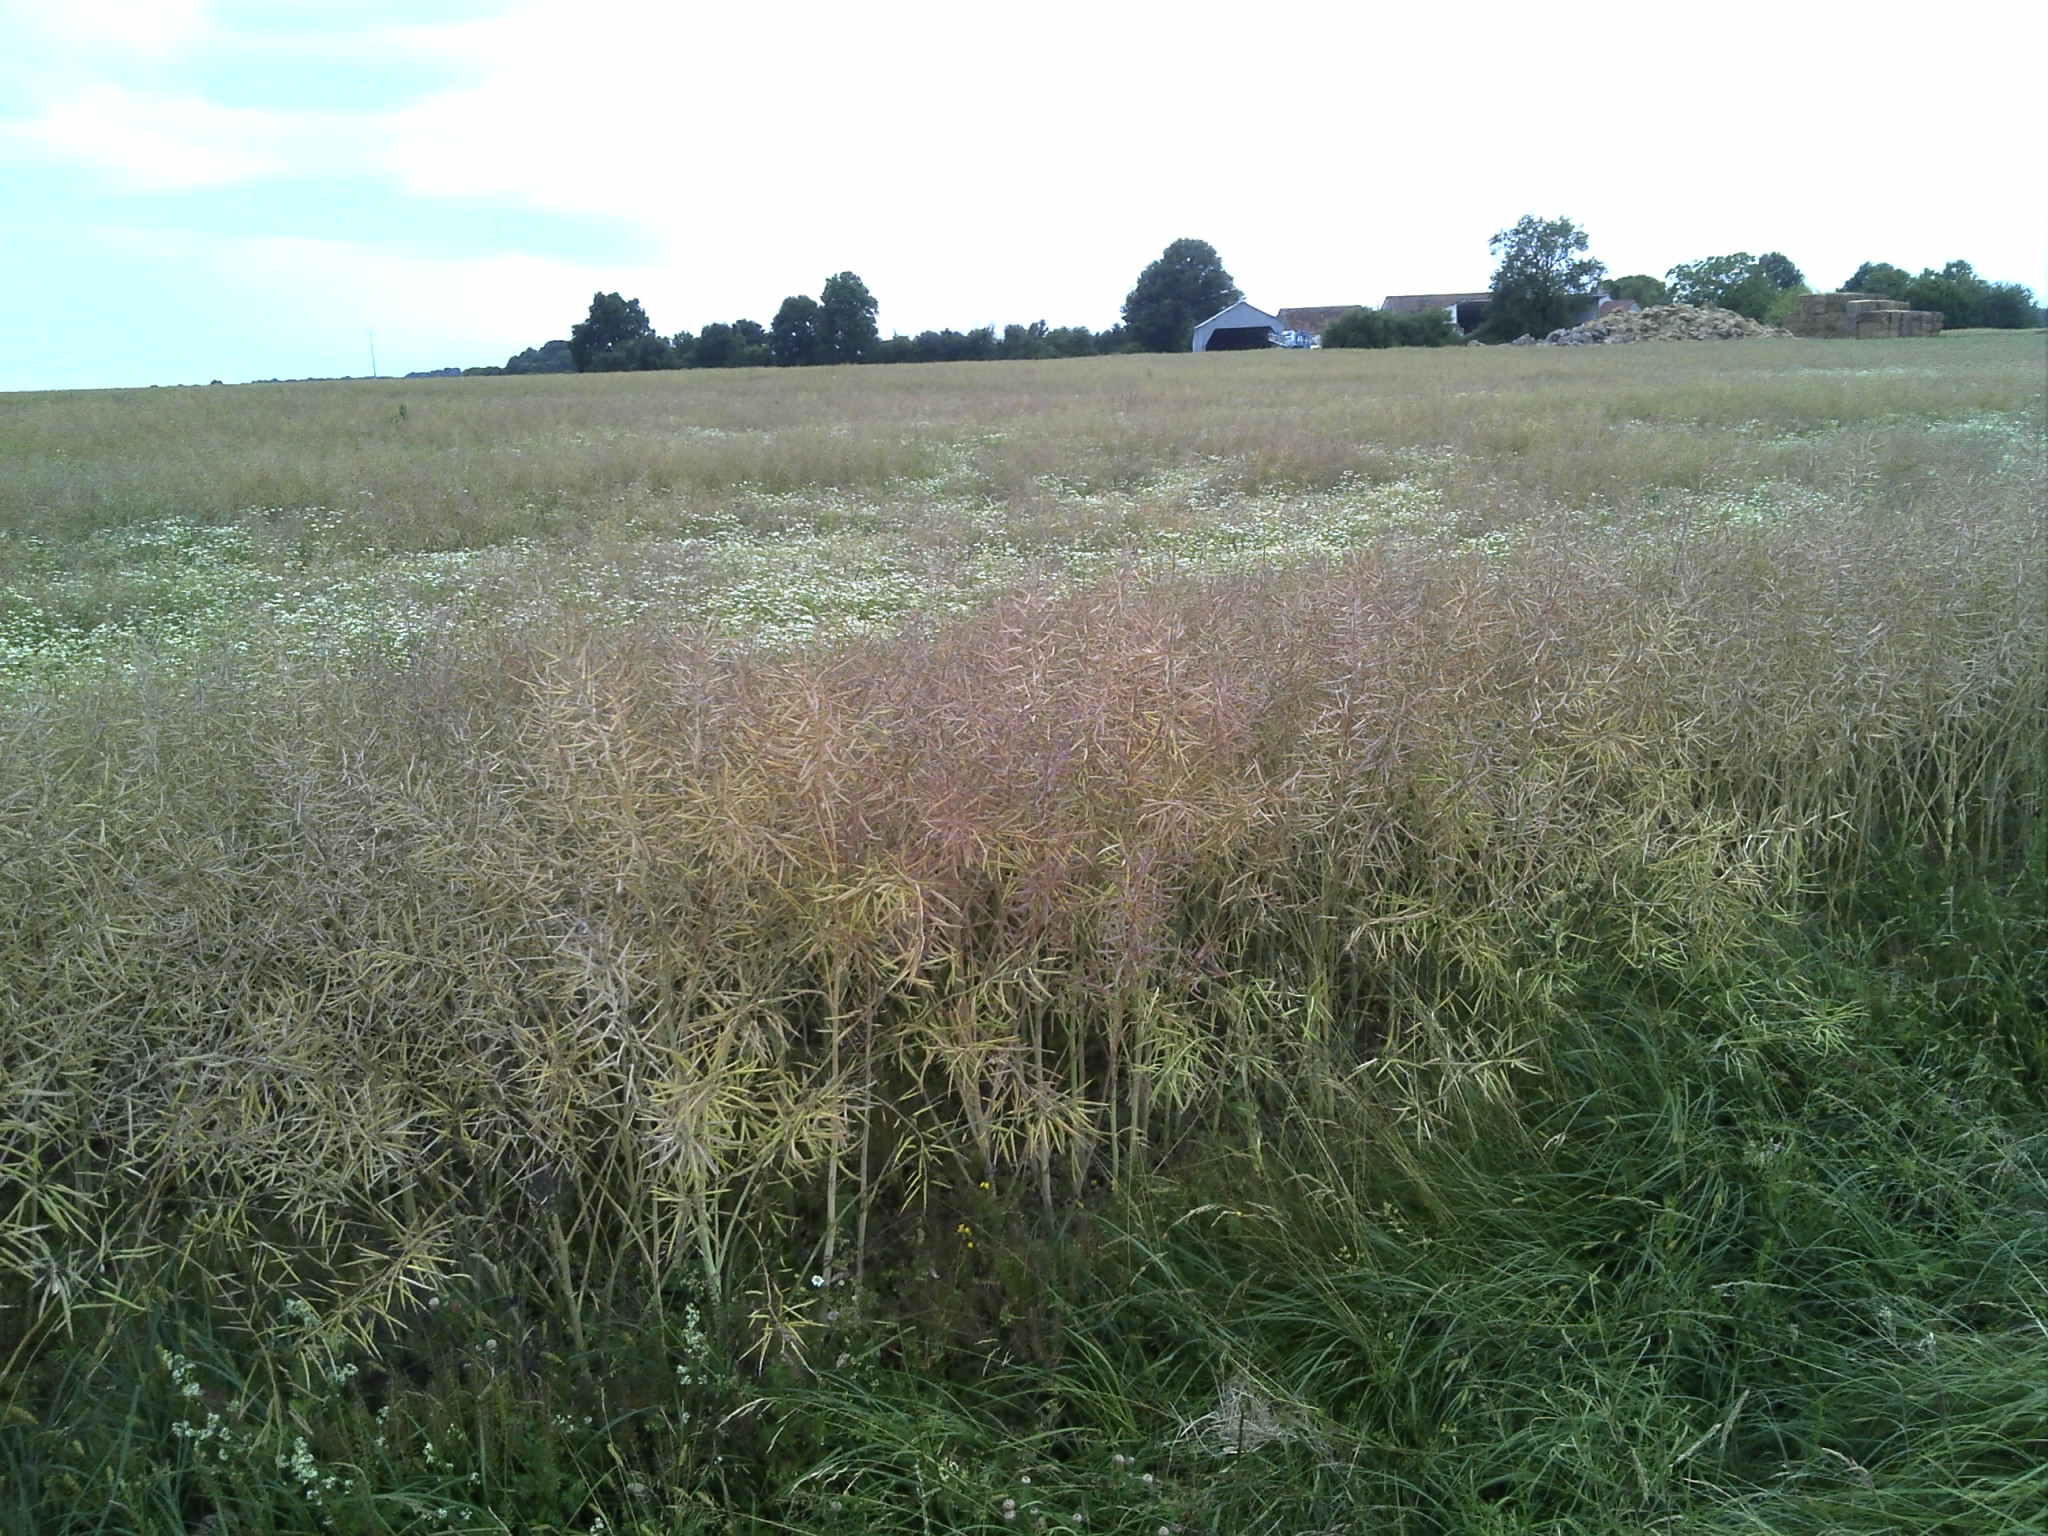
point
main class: Cropland
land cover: Rape and turnip rape
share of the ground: > 75 %
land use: Agriculture (excluding fallow land and kitchen gardens)
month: June
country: FR
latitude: 47.1692
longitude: 1.4778
